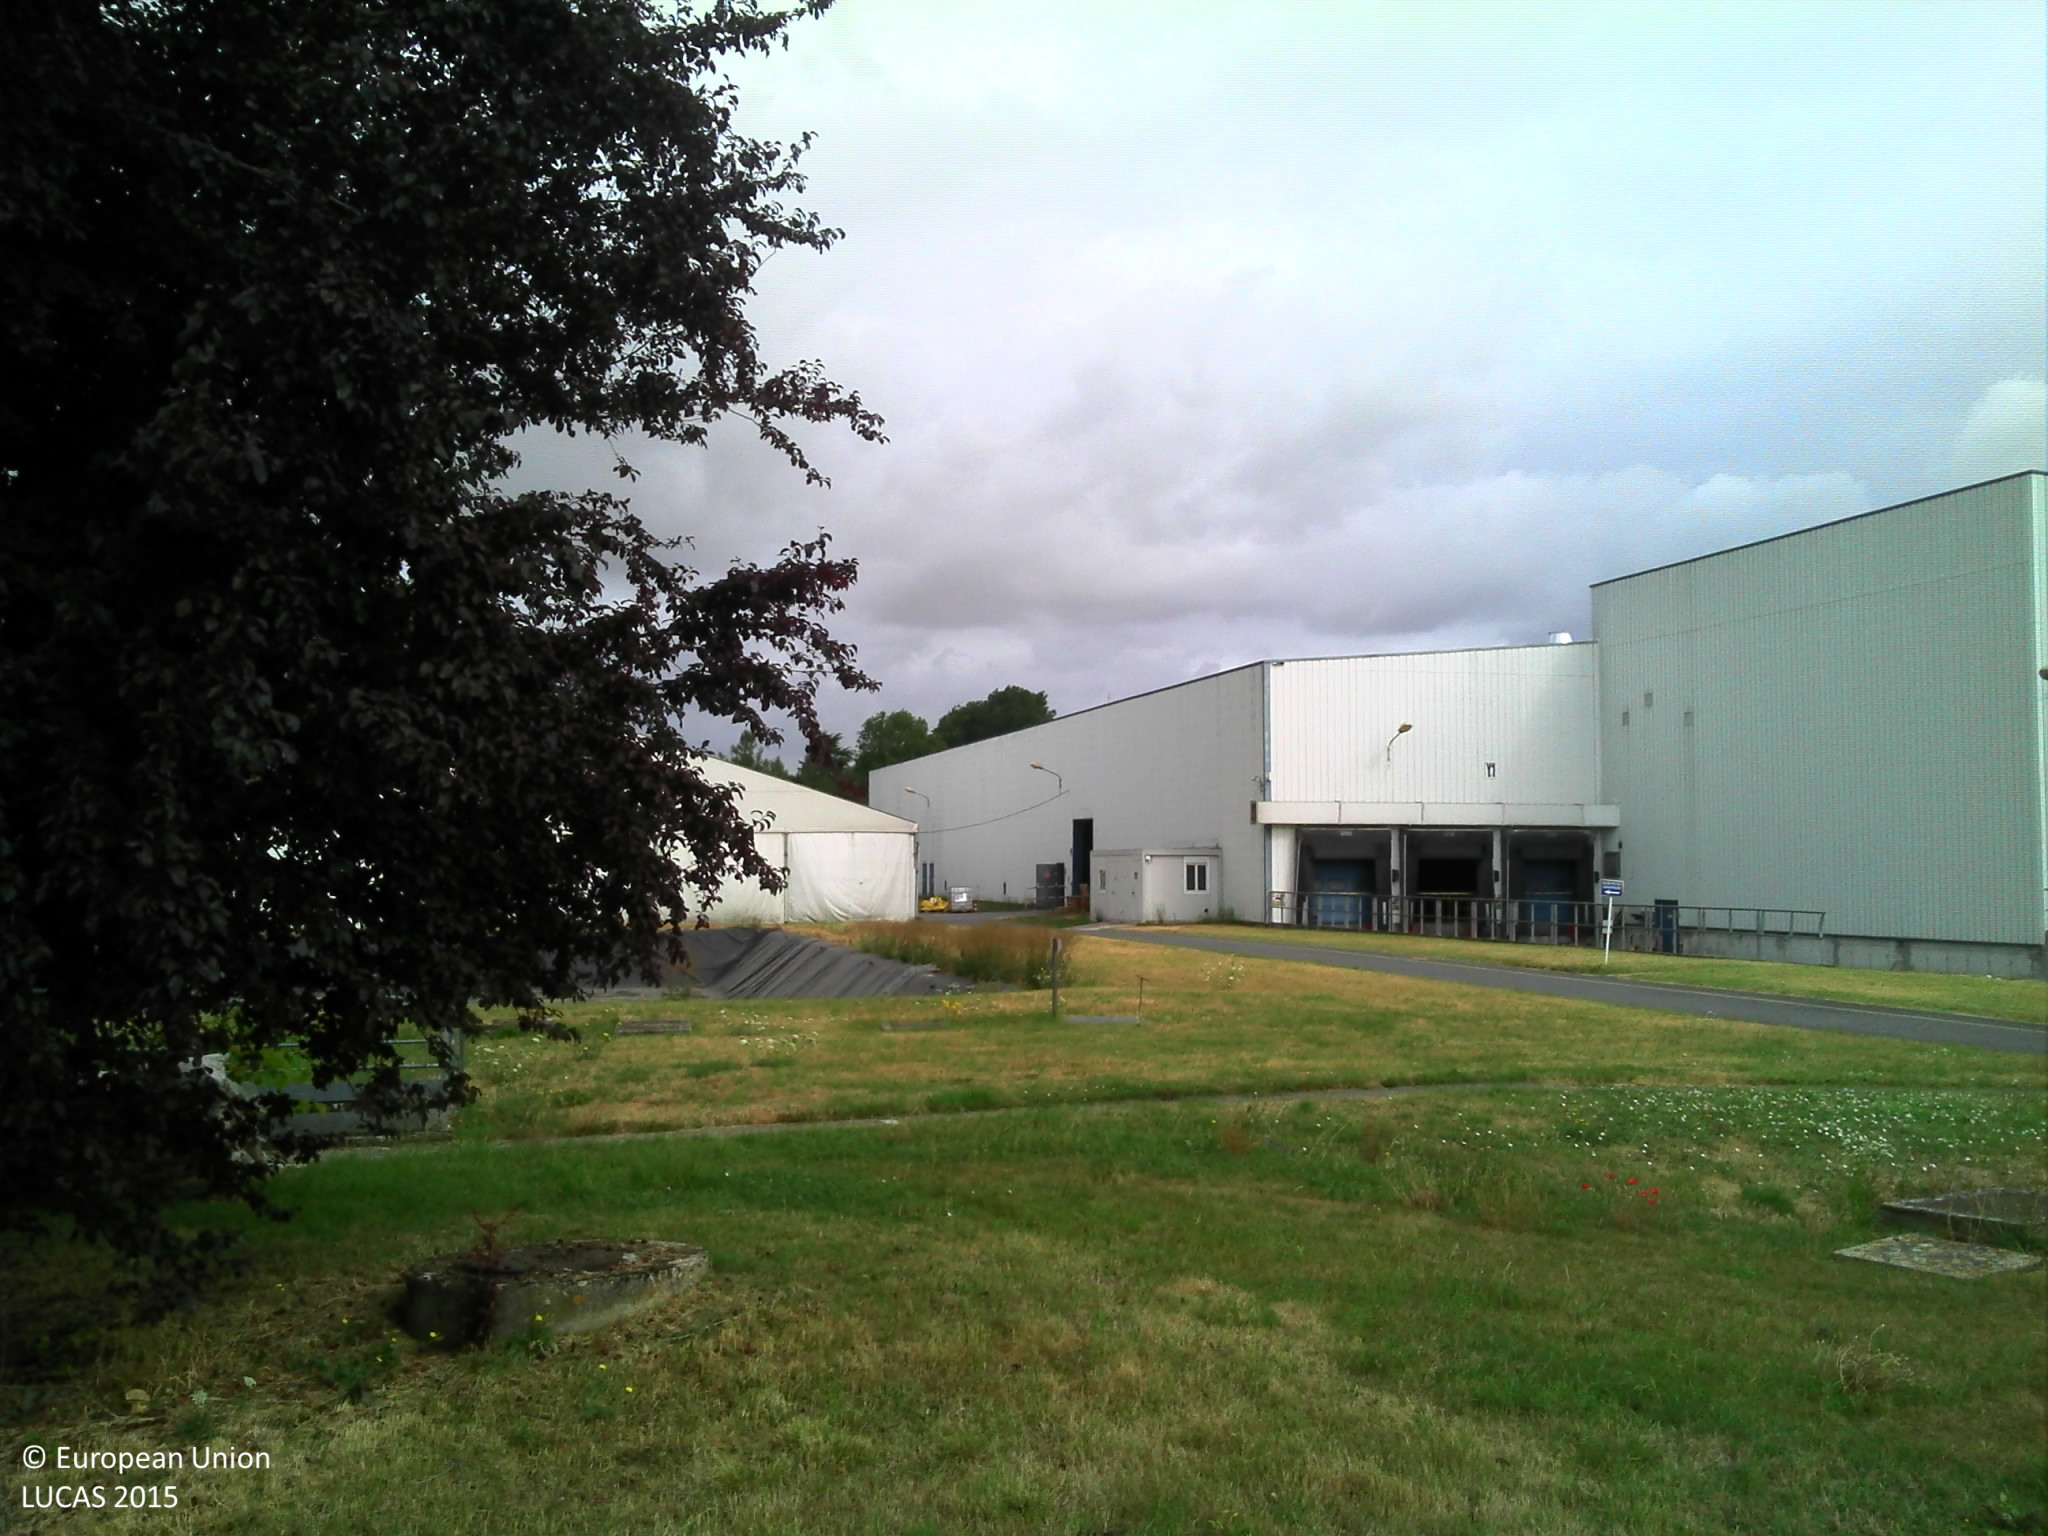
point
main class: Grassland
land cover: Grassland without tree/shrub cover
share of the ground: > 75 %
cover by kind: herbaceous plants 90 %, consolidated bare surface 10 %
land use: Logistics and storage
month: July
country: FR
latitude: 48.6678
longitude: 2.6984
